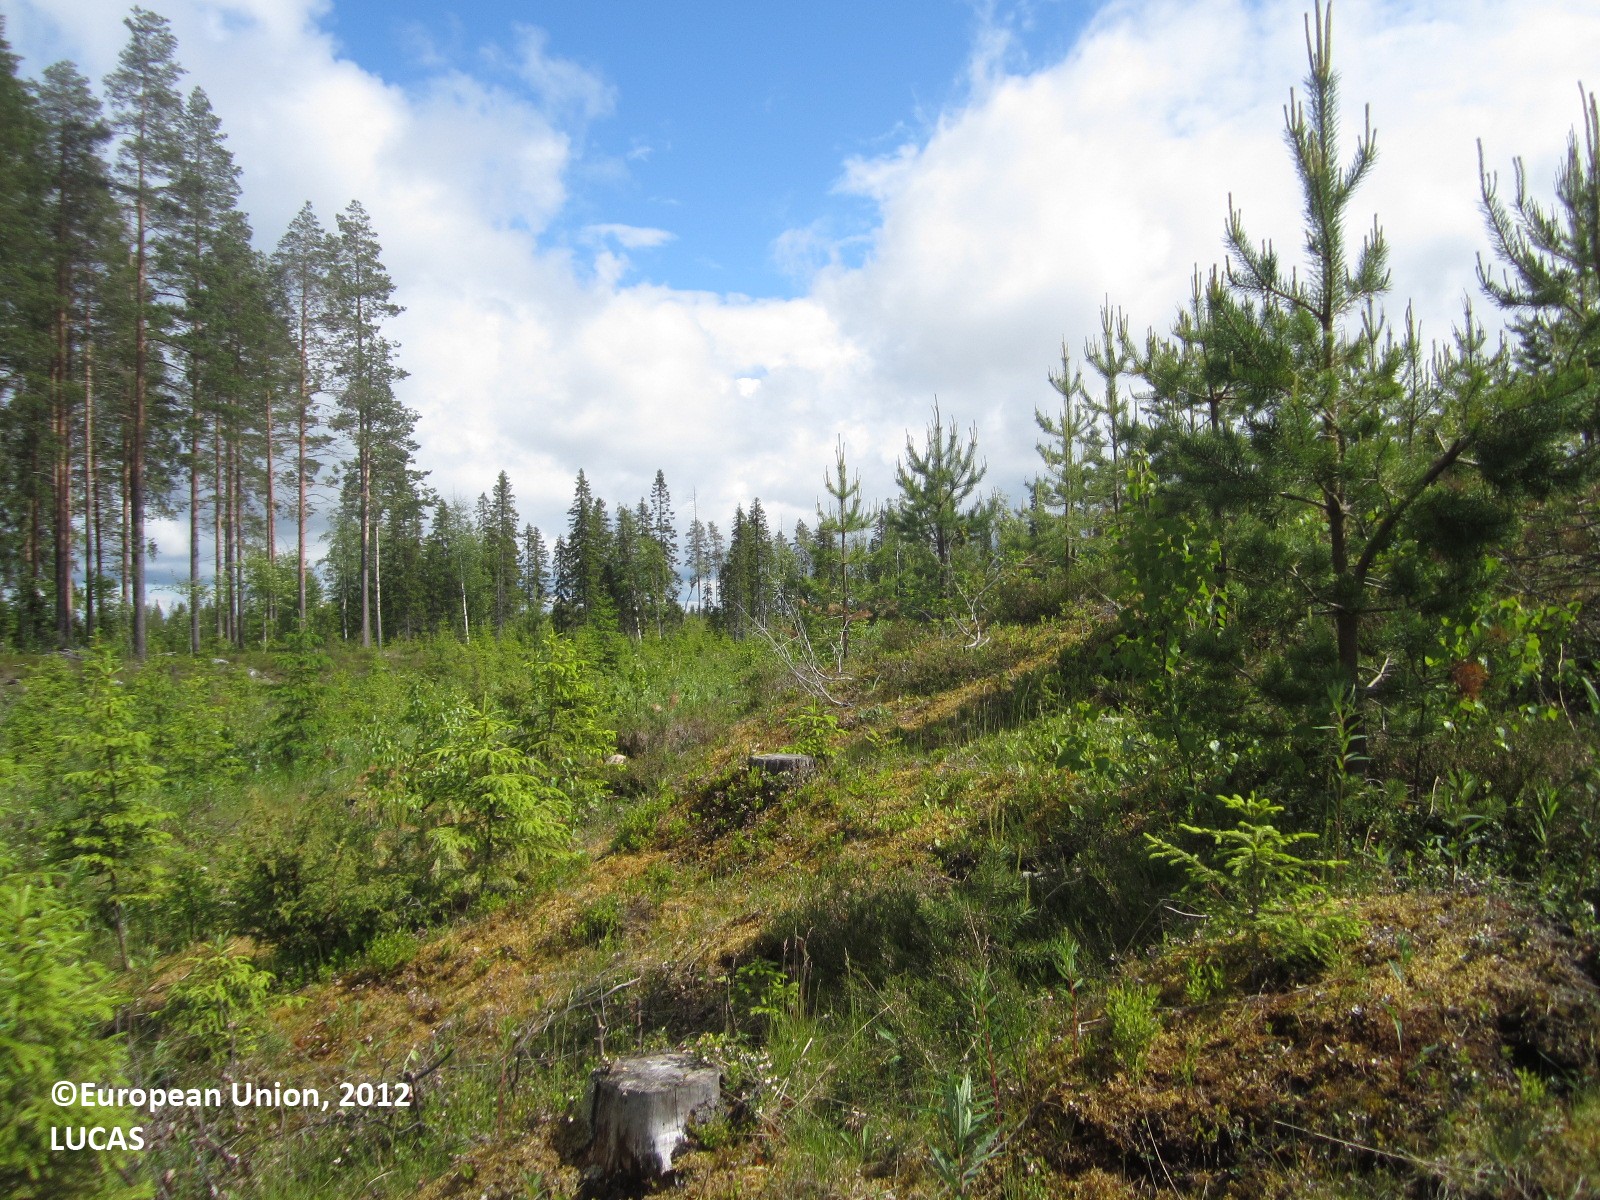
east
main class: Woodland
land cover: Spruce dominated coniferous woodland
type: boreal forest
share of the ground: 25 - 50 %
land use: Forestry
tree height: < 5 m
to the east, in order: Spruce dominated coniferous woodland
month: June
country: FI
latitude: 64.3541
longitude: 29.7536
